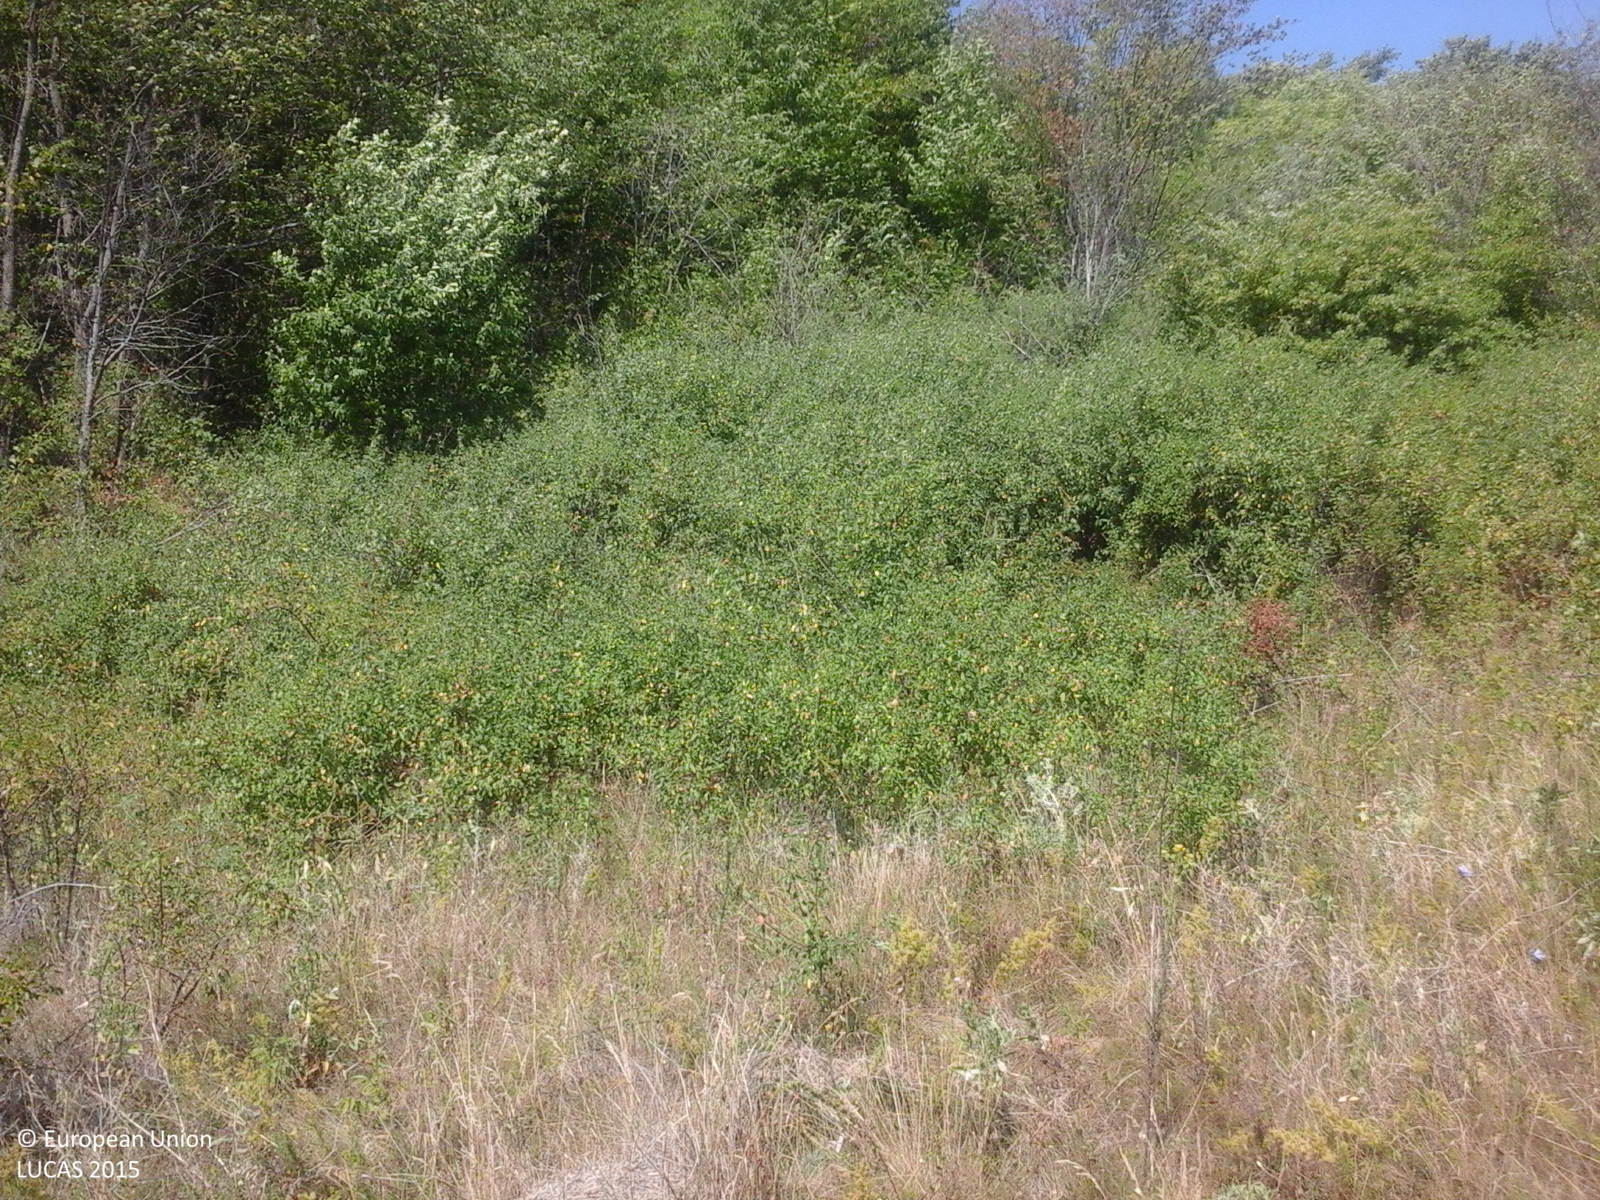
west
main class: Shrubland
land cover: Shrubland with sparse tree cover
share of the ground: > 75 %
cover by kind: shrubs 75 %, herbaceous plants 20 %, broadleaved forest trees 5 %
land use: Semi-natural and natural areas not in use
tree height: > 5 m
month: July
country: RO
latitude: 46.5412
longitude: 27.2244
